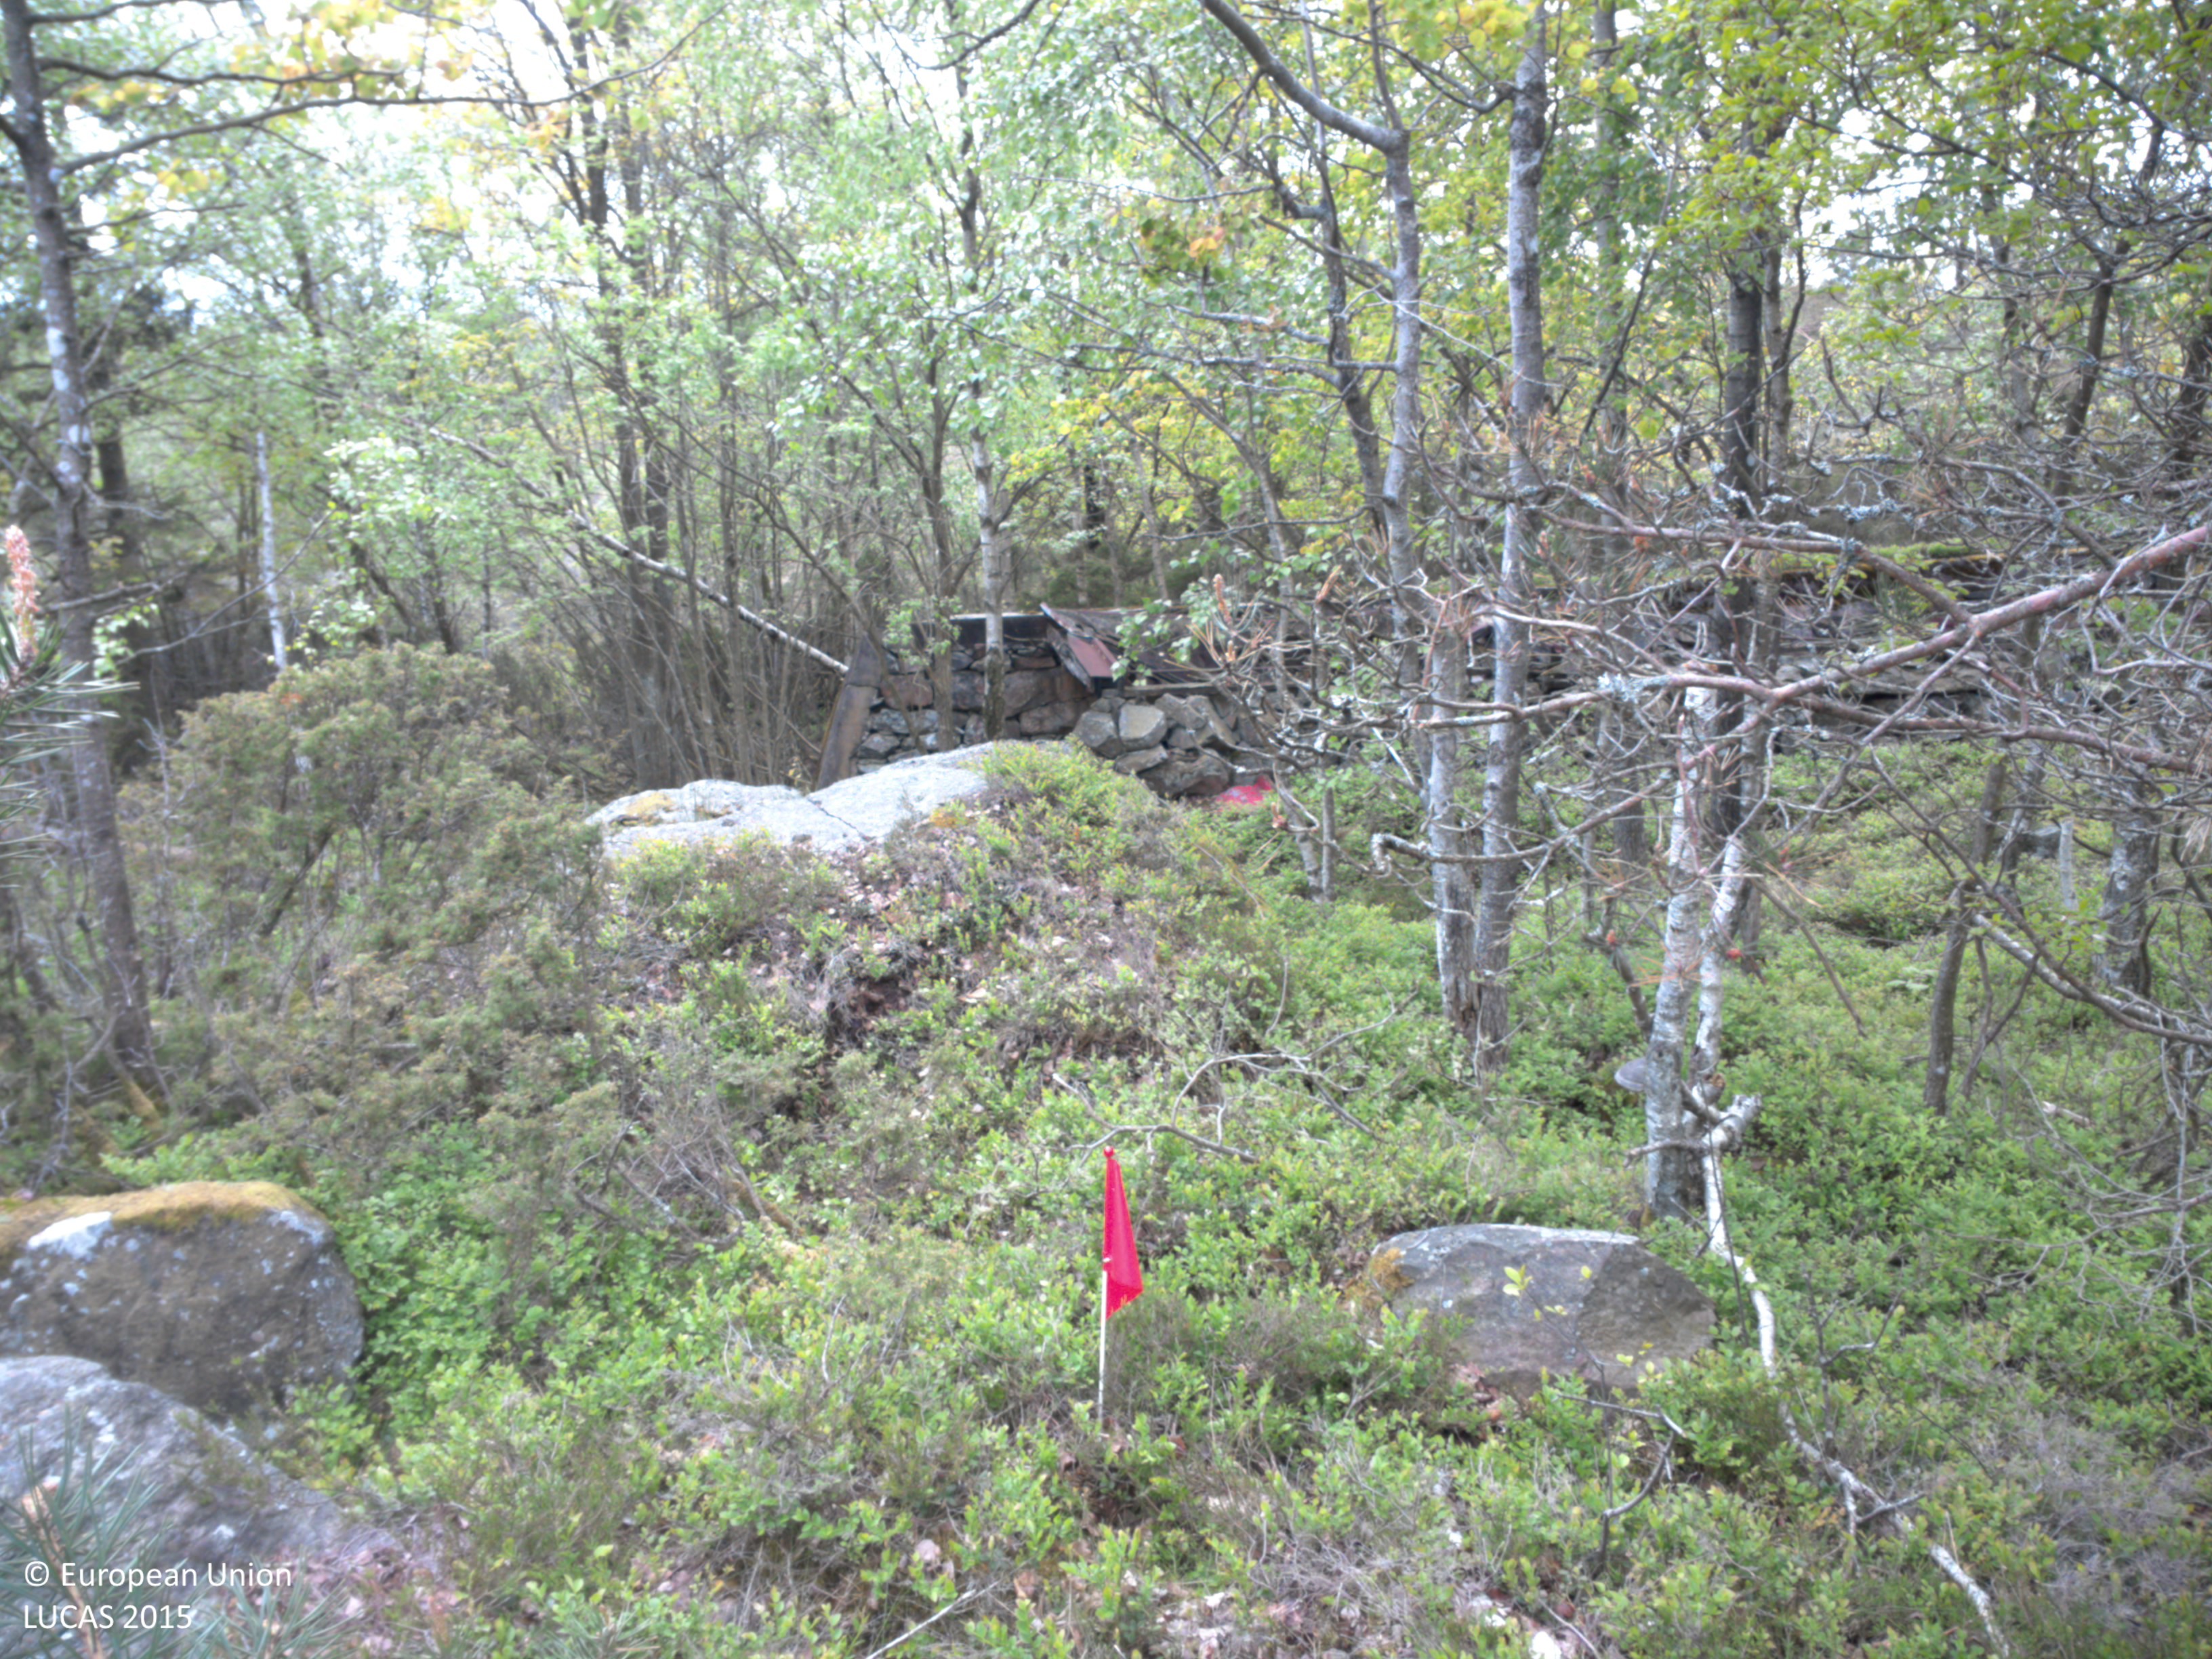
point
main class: Woodland
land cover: Other mixed woodland
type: hemiboreal forest and nemoral coniferous forest and mixed broadleaved-coniferous forest
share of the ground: 50 - 75 %
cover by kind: broadleaved forest trees 40 %, coniferous forest trees 20 %, shrubs 20 %, herbaceous plants 20 %
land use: Forestry
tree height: > 5 m
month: May
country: SE
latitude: 58.2278
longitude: 11.6144
